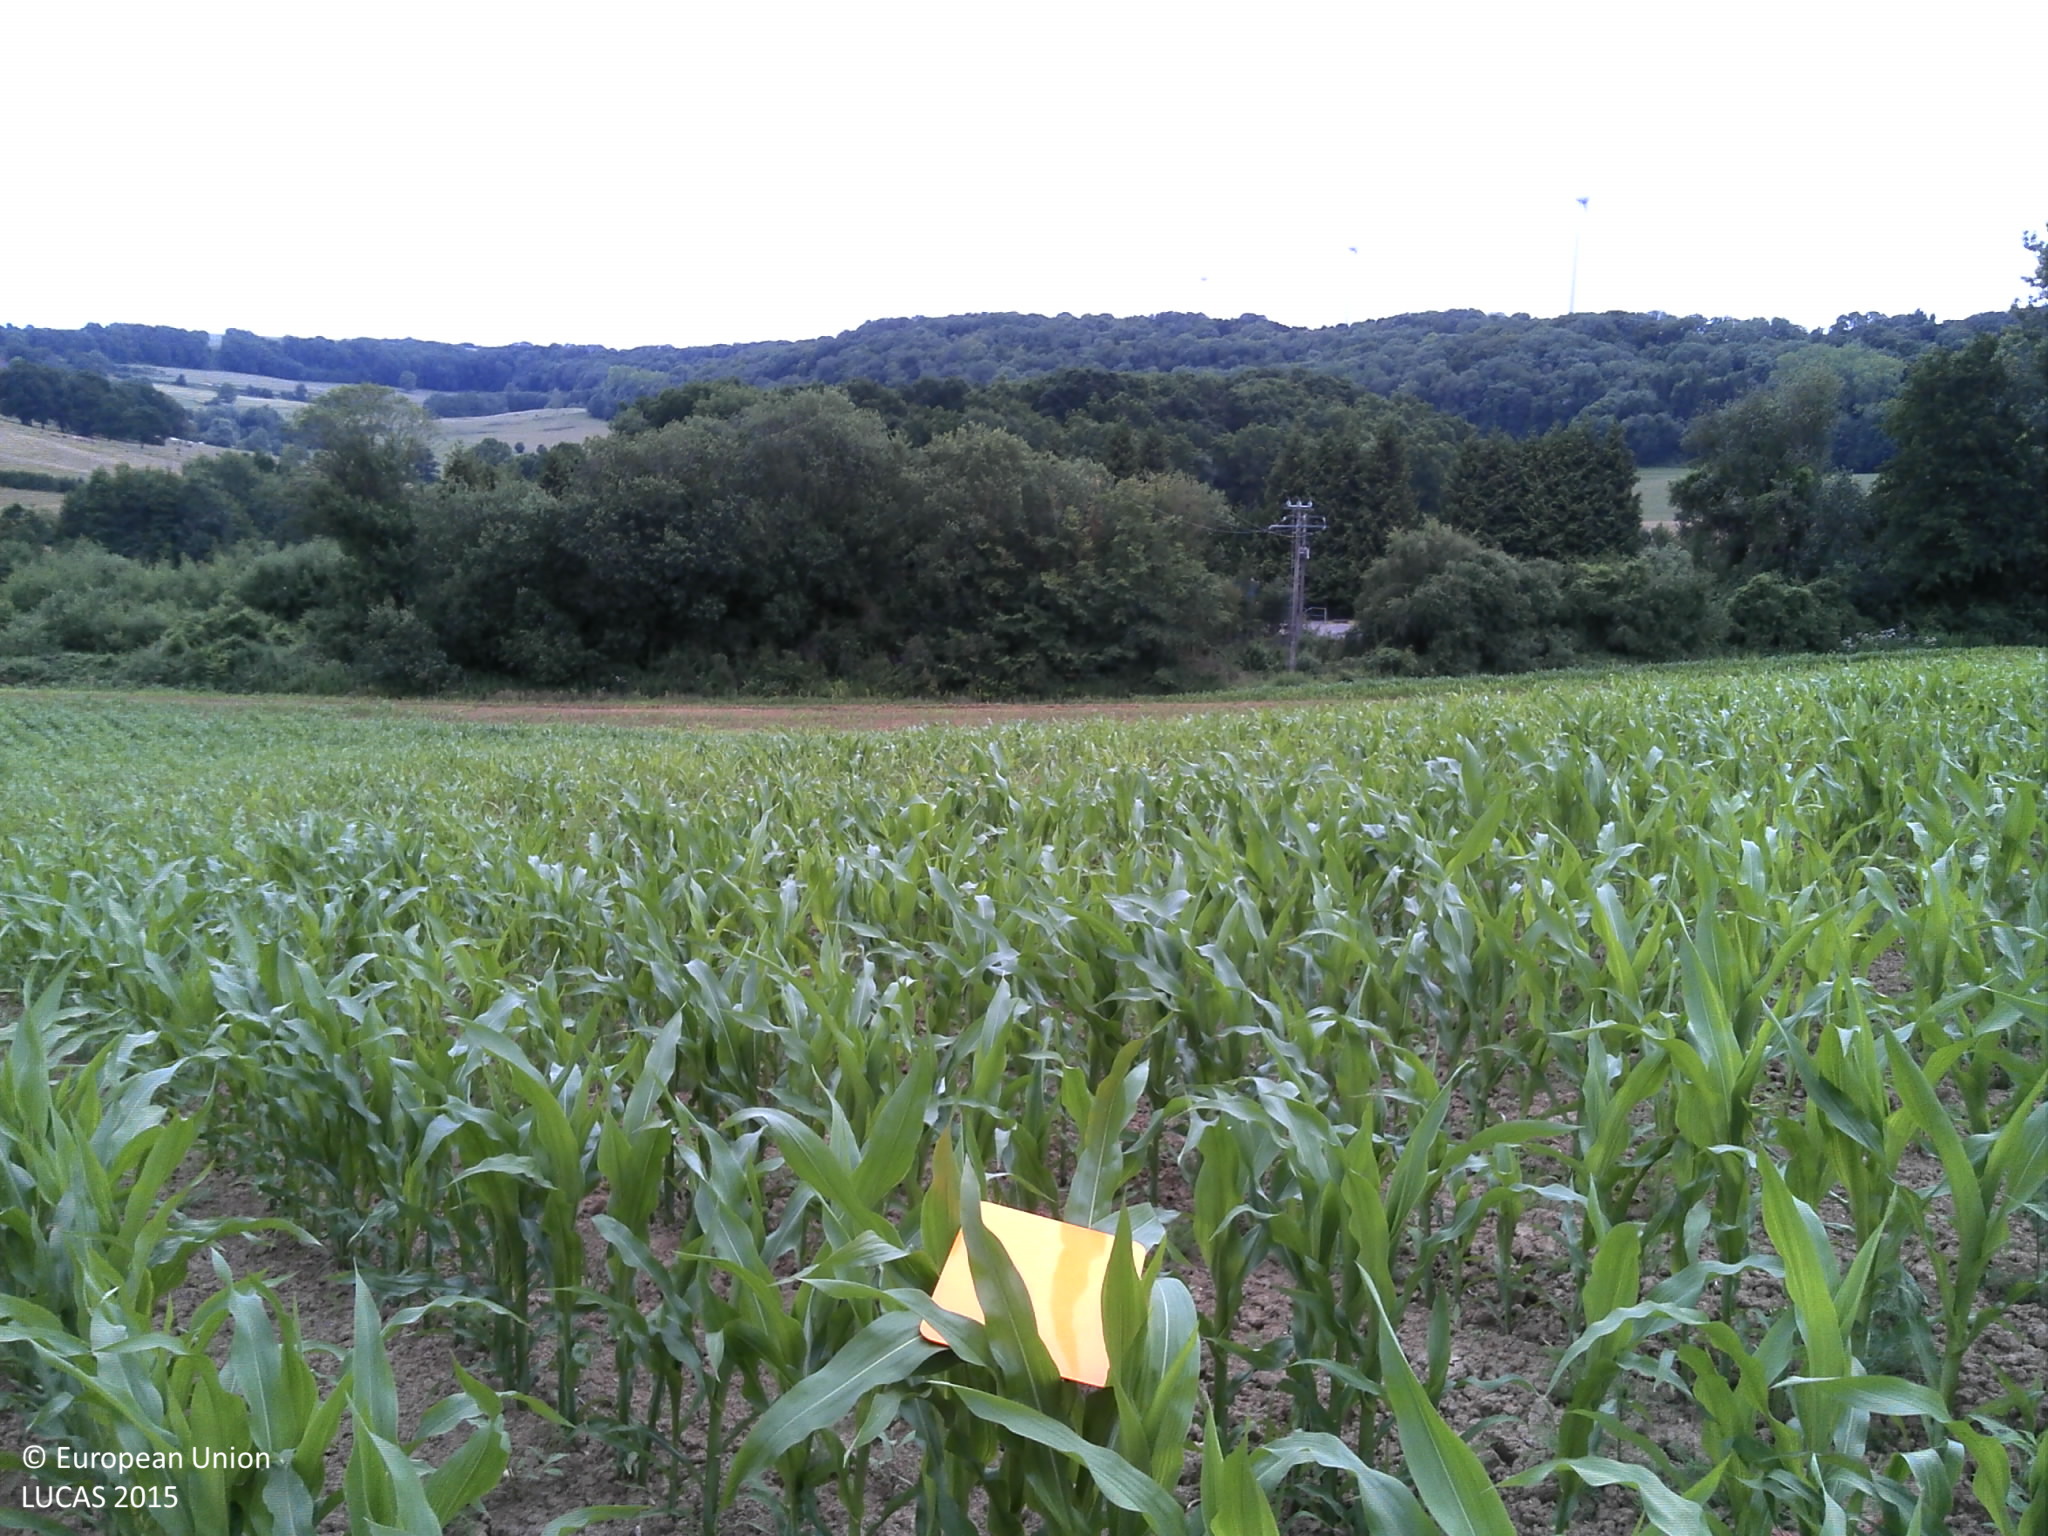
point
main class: Cropland
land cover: Maize
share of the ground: 25 - 50 %
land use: Agriculture (excluding fallow land and kitchen gardens)
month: June
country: FR
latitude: 49.6110
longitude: 5.1124
